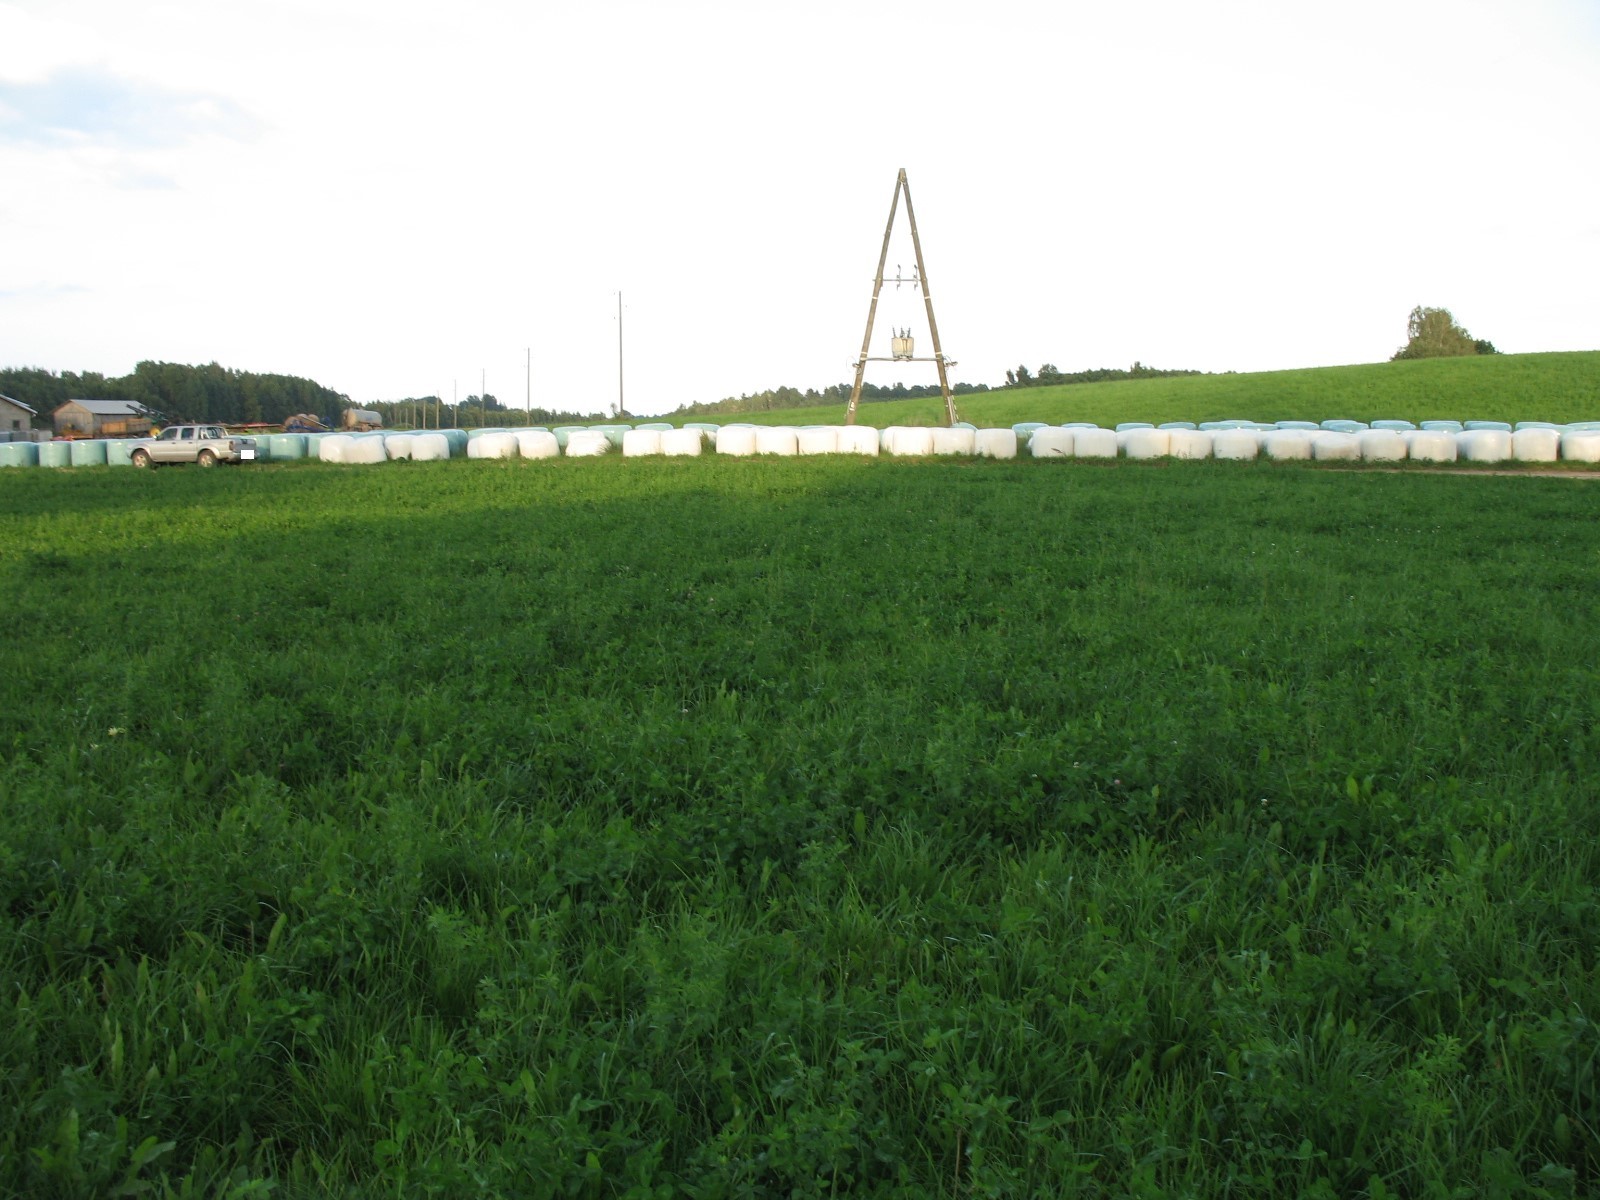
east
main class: Grassland
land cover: Grassland without tree/shrub cover
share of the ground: > 75 %
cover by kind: herbaceous plants 100 %
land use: Agriculture (excluding fallow land and kitchen gardens)
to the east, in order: Grassland without tree/shrub cover; Ditches and canals; Grass margins; Paved roads, cycling and walking lanes; Grassland without tree/shrub cover; Electric lines; Grassland without tree/shrub cover
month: August
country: LV
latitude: 56.2894
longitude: 25.4518
